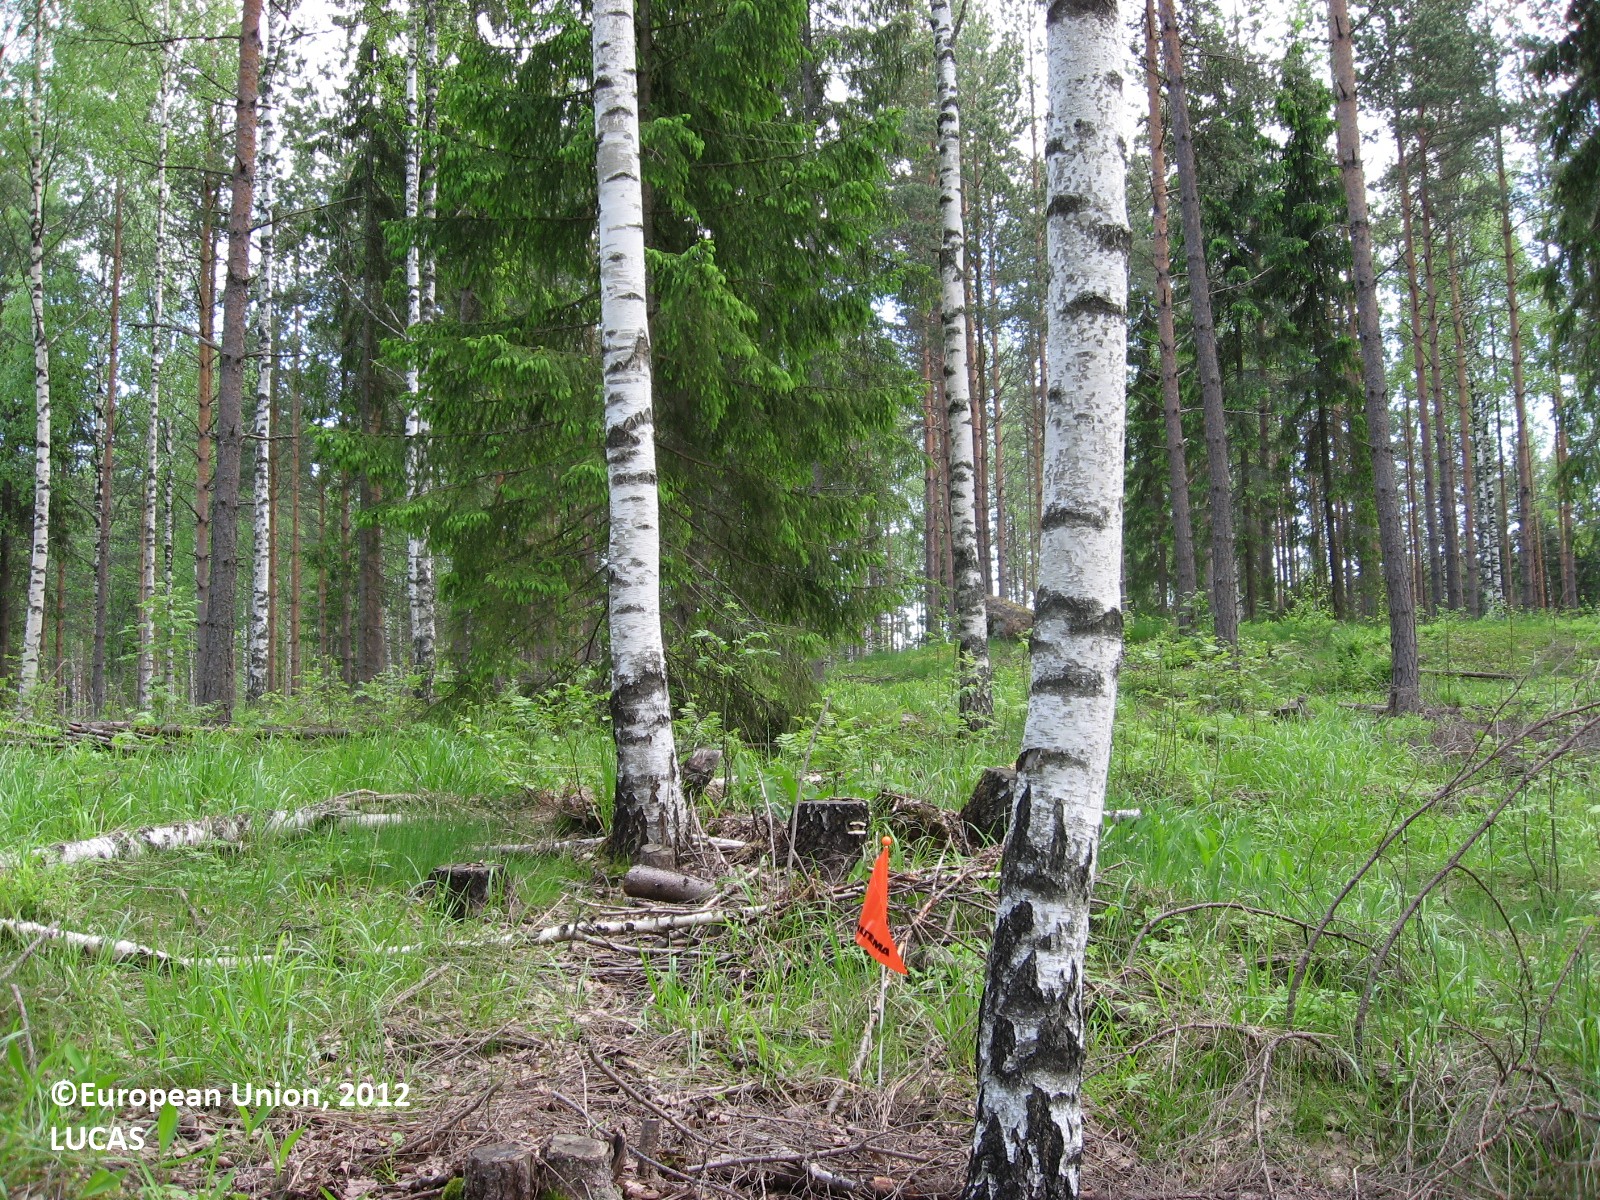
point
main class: Woodland
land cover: Other mixed woodland
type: boreal forest
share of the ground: > 75 %
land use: Forestry
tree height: > 5 m
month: June
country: FI
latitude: 60.4131
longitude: 25.3975
